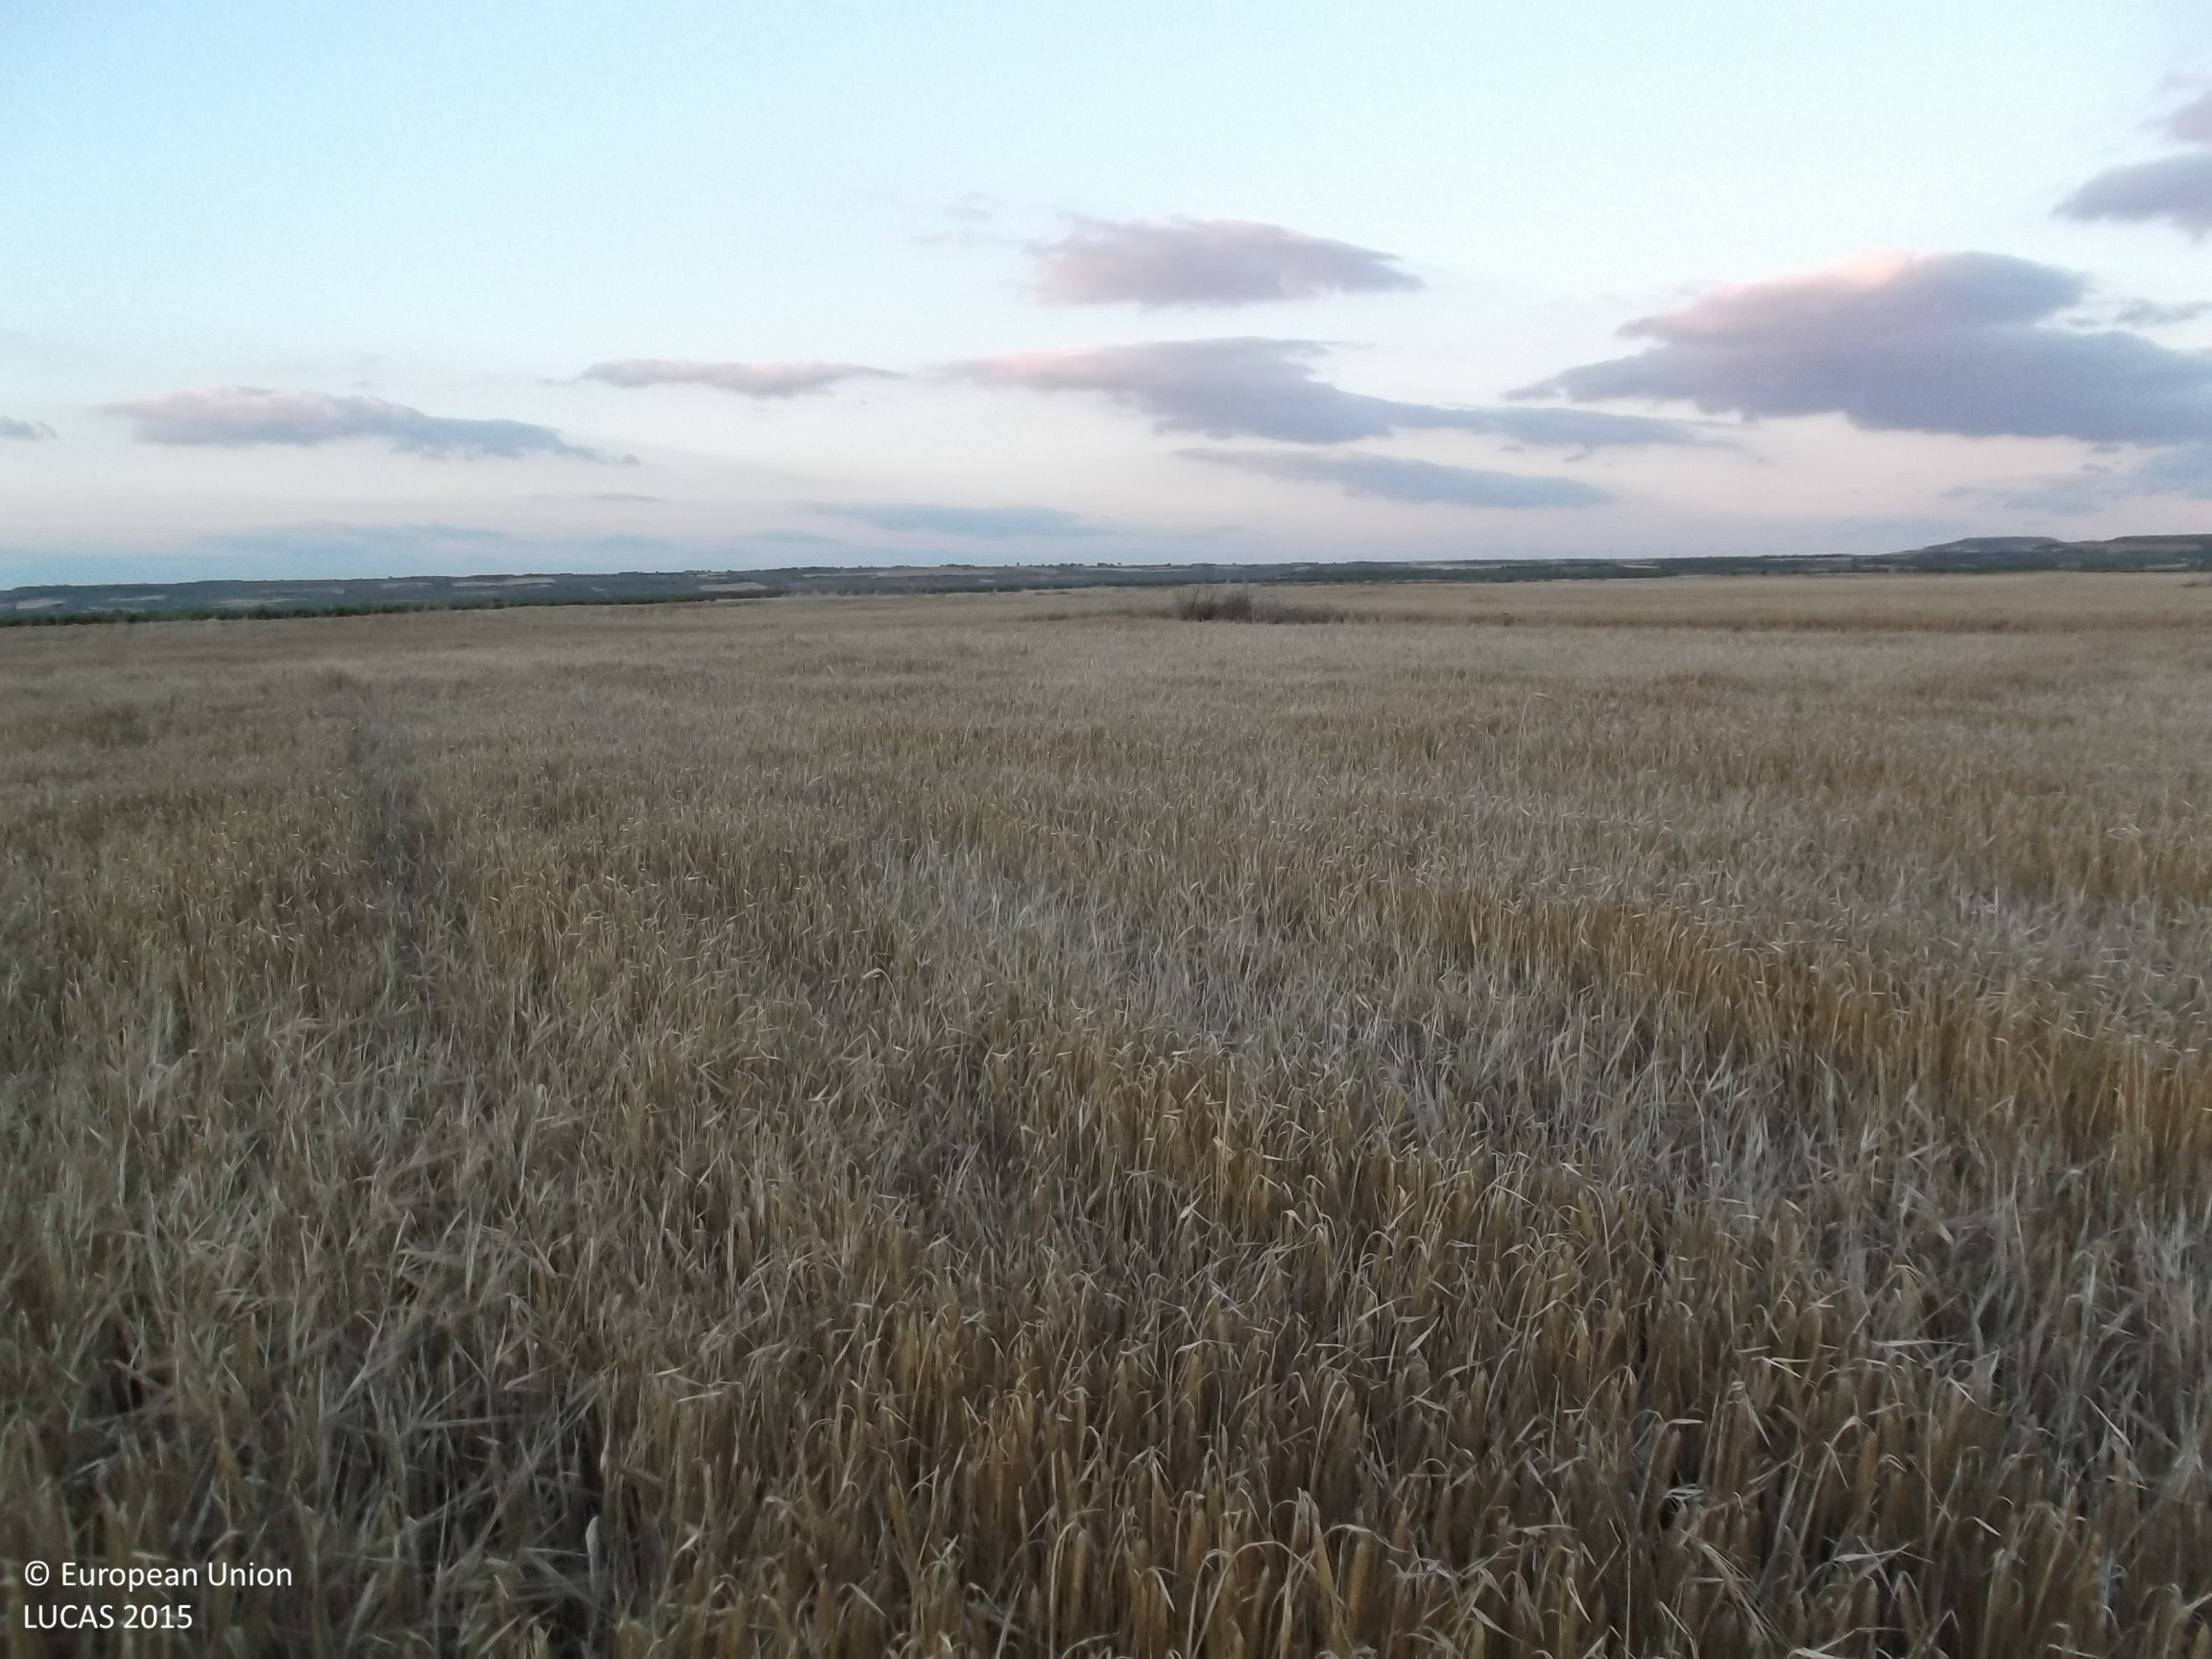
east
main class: Cropland
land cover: Barley
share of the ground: > 75 %
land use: Agriculture (excluding fallow land and kitchen gardens)
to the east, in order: Barley; Grass margins; Barley; Spontaneously vegetated surfaces; Barley; Vineyards
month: June
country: ES
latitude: 42.3703
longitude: -2.3440
